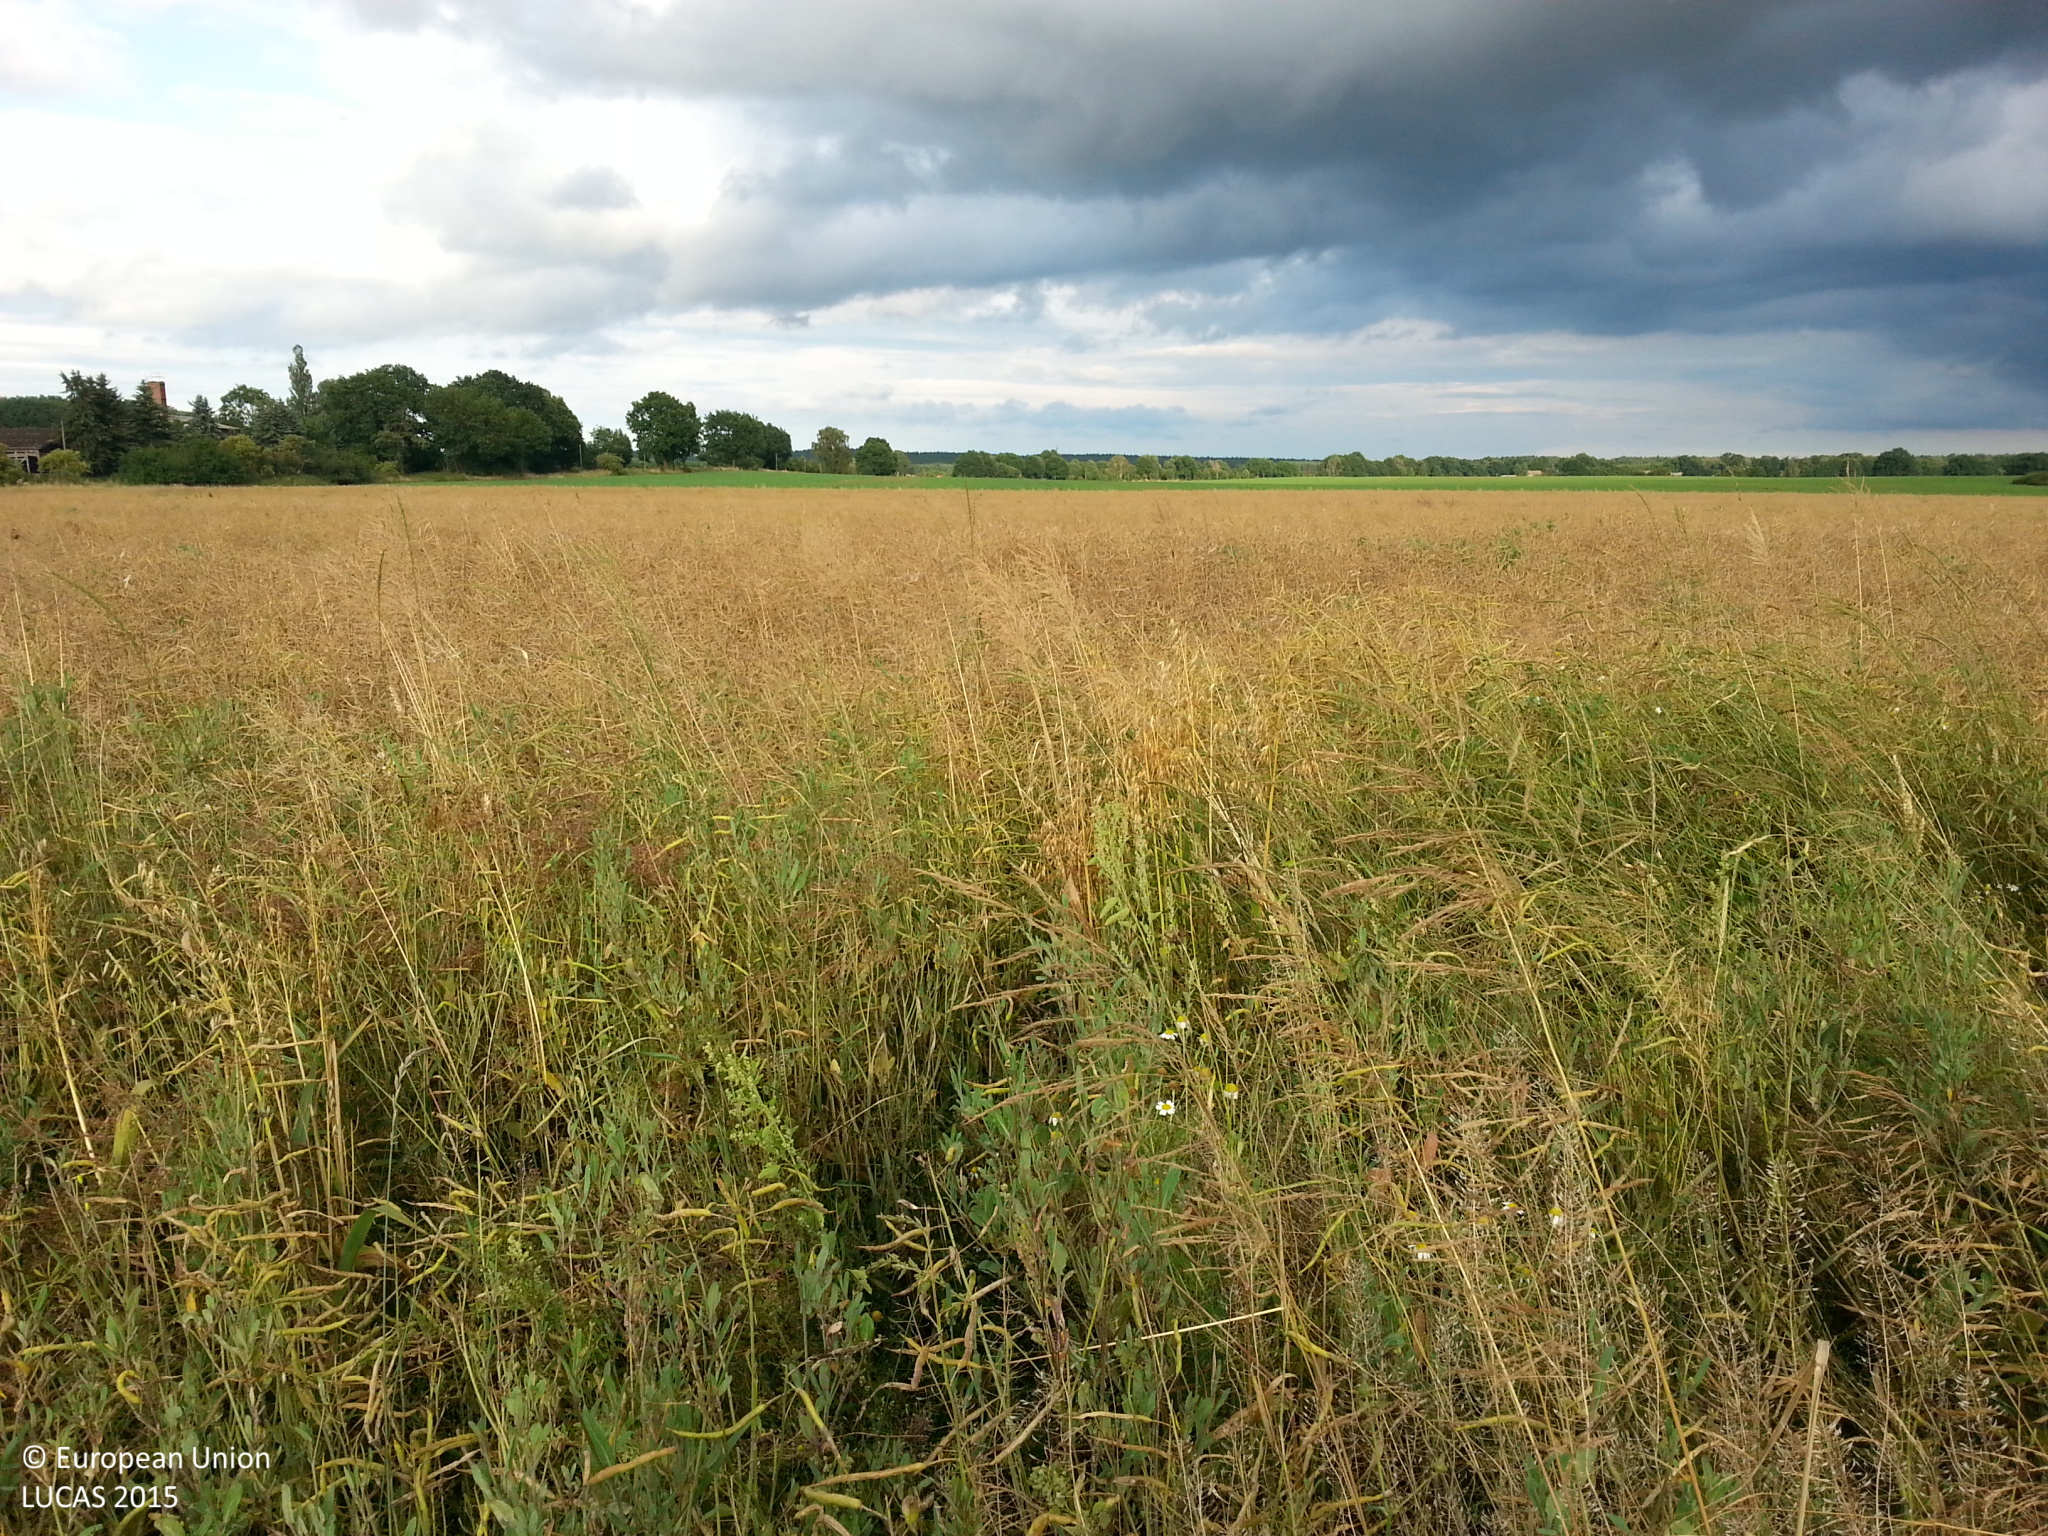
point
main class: Cropland
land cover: Rape and turnip rape
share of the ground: > 75 %
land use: Agriculture (excluding fallow land and kitchen gardens)
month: July
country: DE
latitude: 53.1257
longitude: 12.4353
